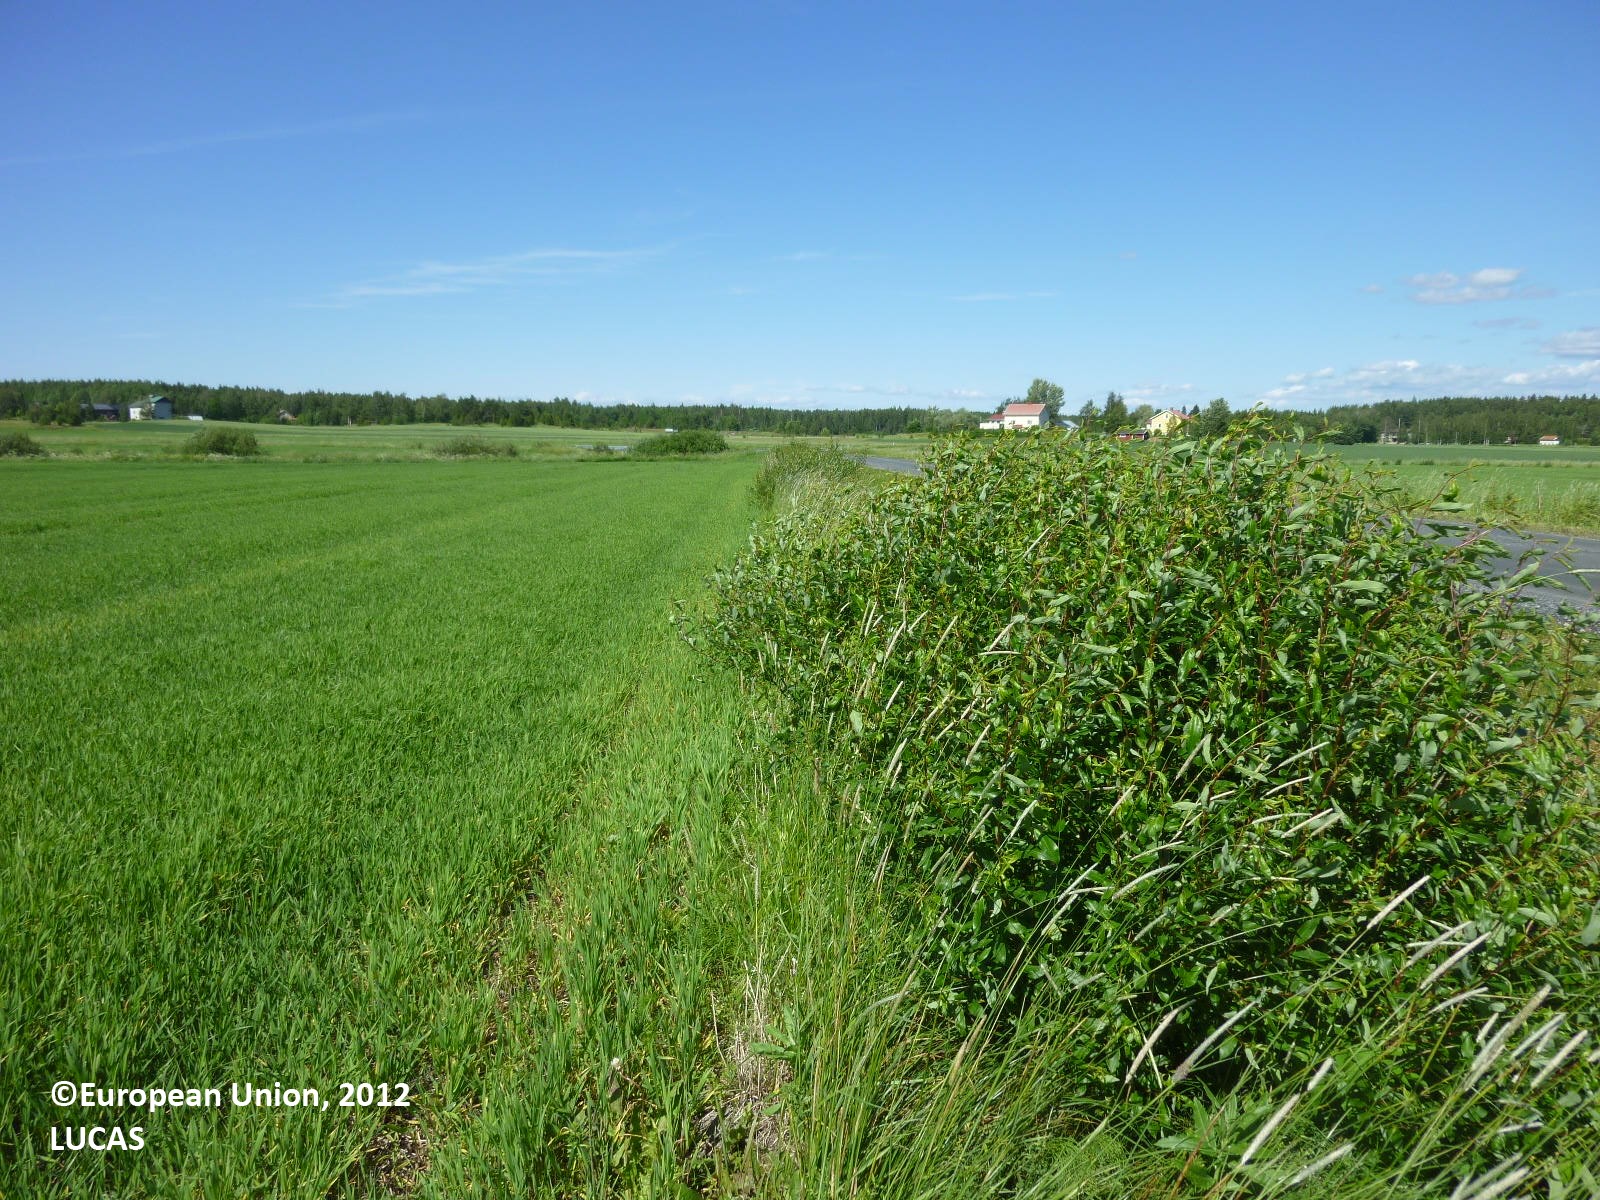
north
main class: Cropland
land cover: Barley
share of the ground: > 75 %
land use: Agriculture (excluding fallow land and kitchen gardens)
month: June
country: FI
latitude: 60.1081
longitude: 22.5761
